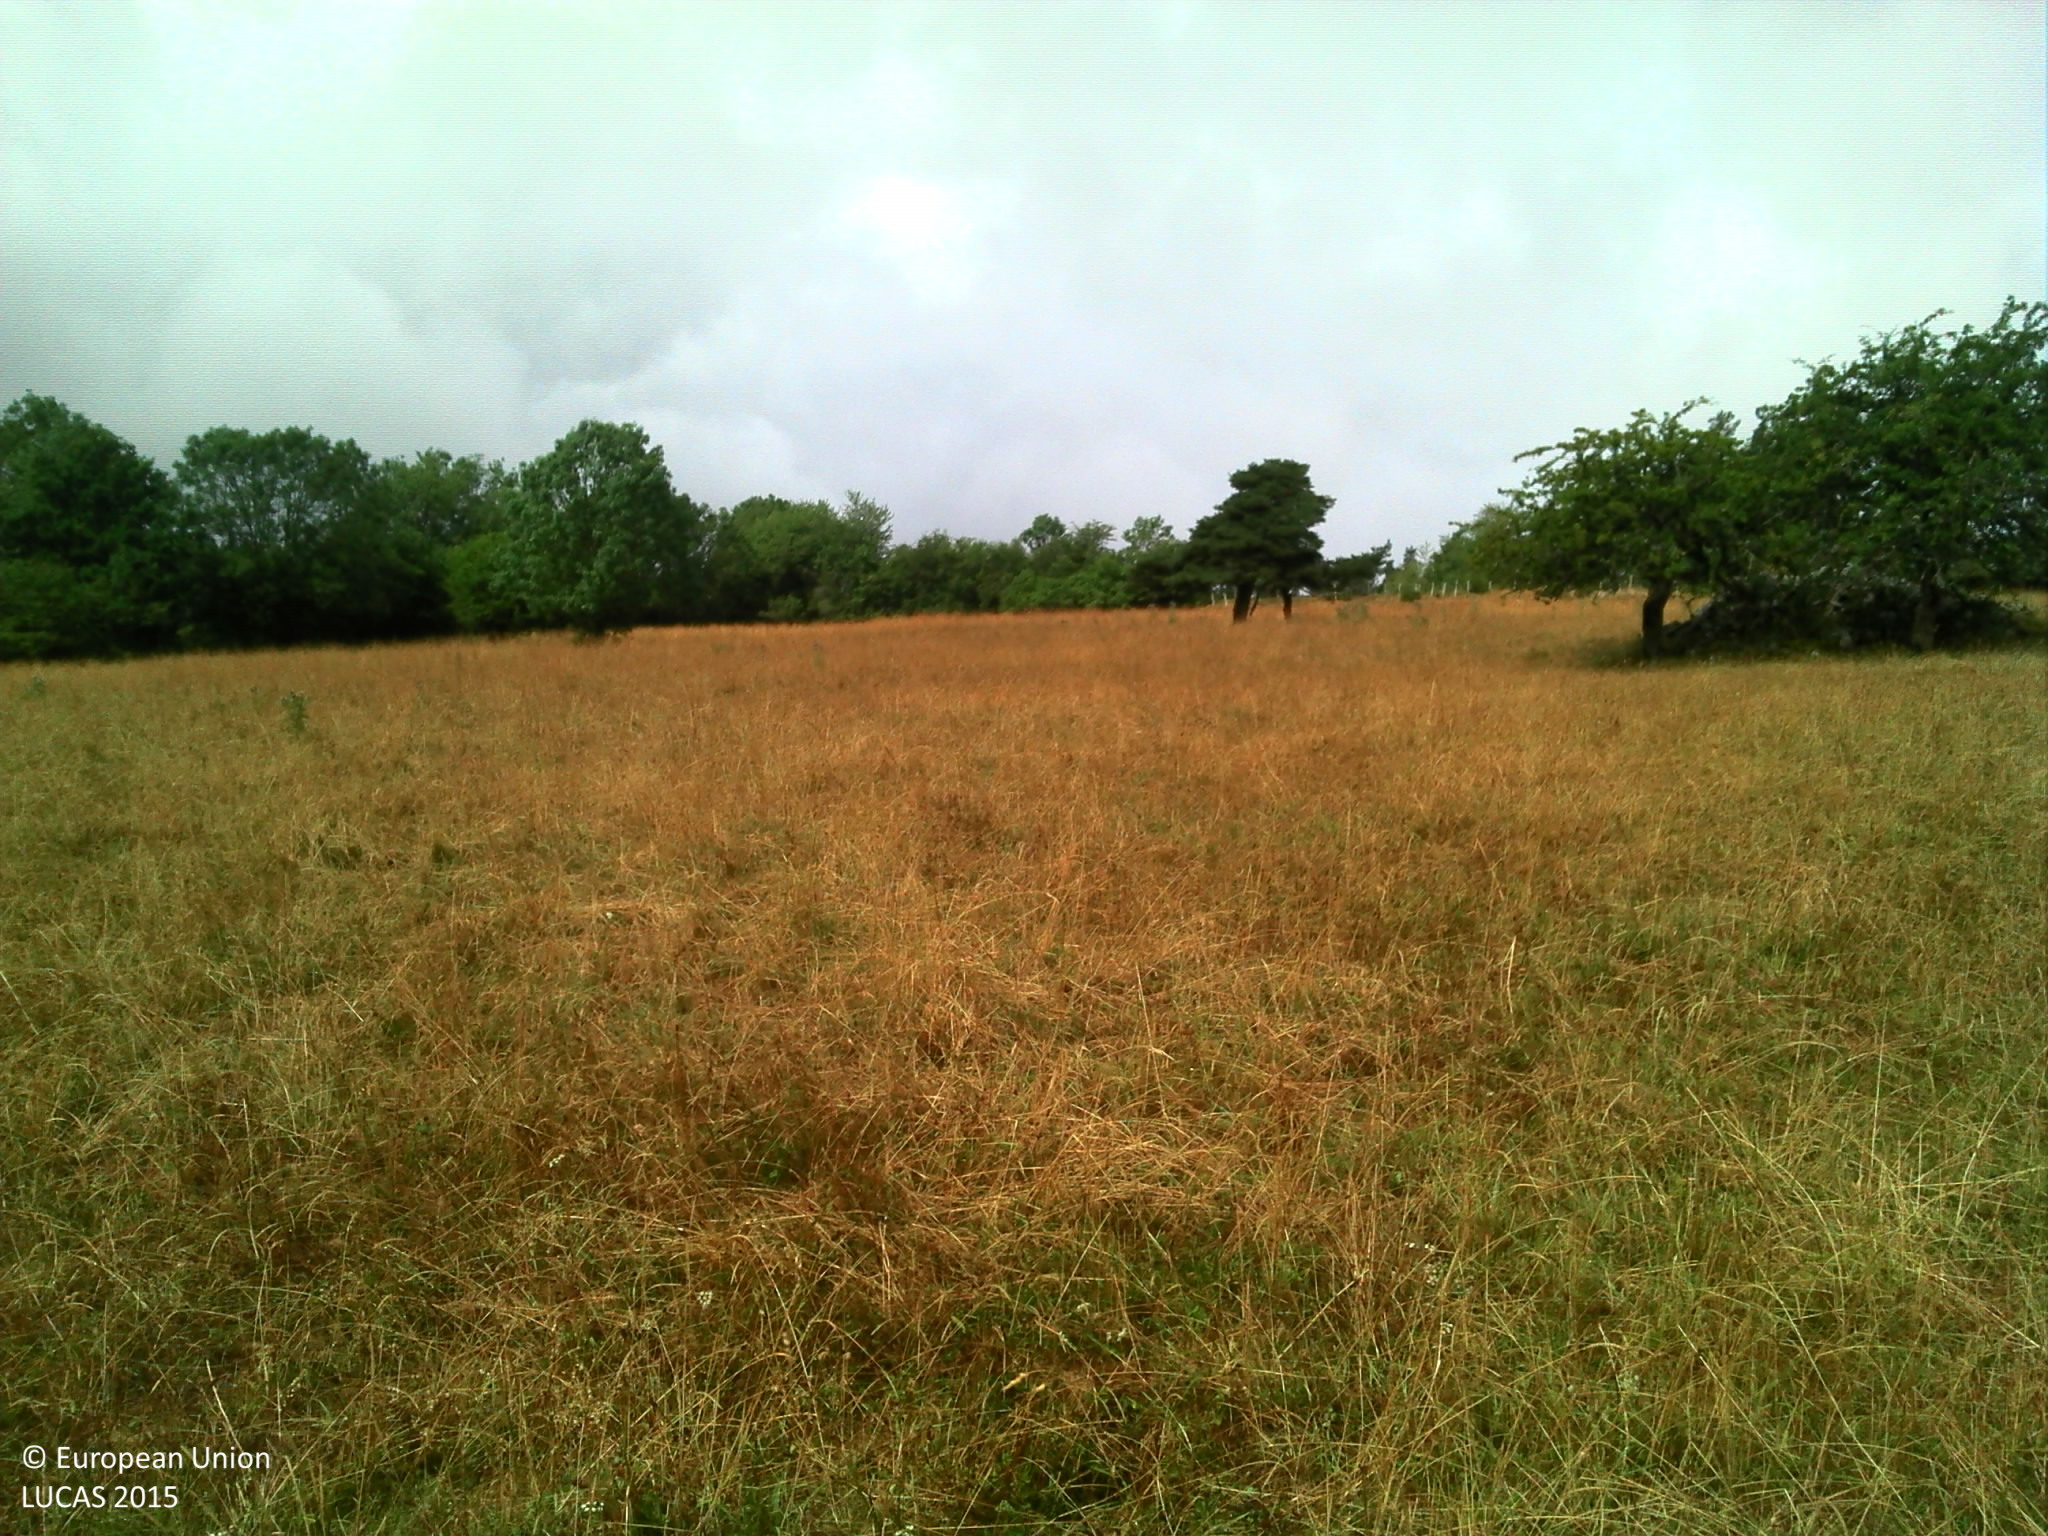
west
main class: Grassland
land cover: Grassland without tree/shrub cover
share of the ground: > 75 %
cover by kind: herbaceous plants 100 %
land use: Agriculture (excluding fallow land and kitchen gardens)
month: July
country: FR
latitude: 44.9408
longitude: 2.9180
